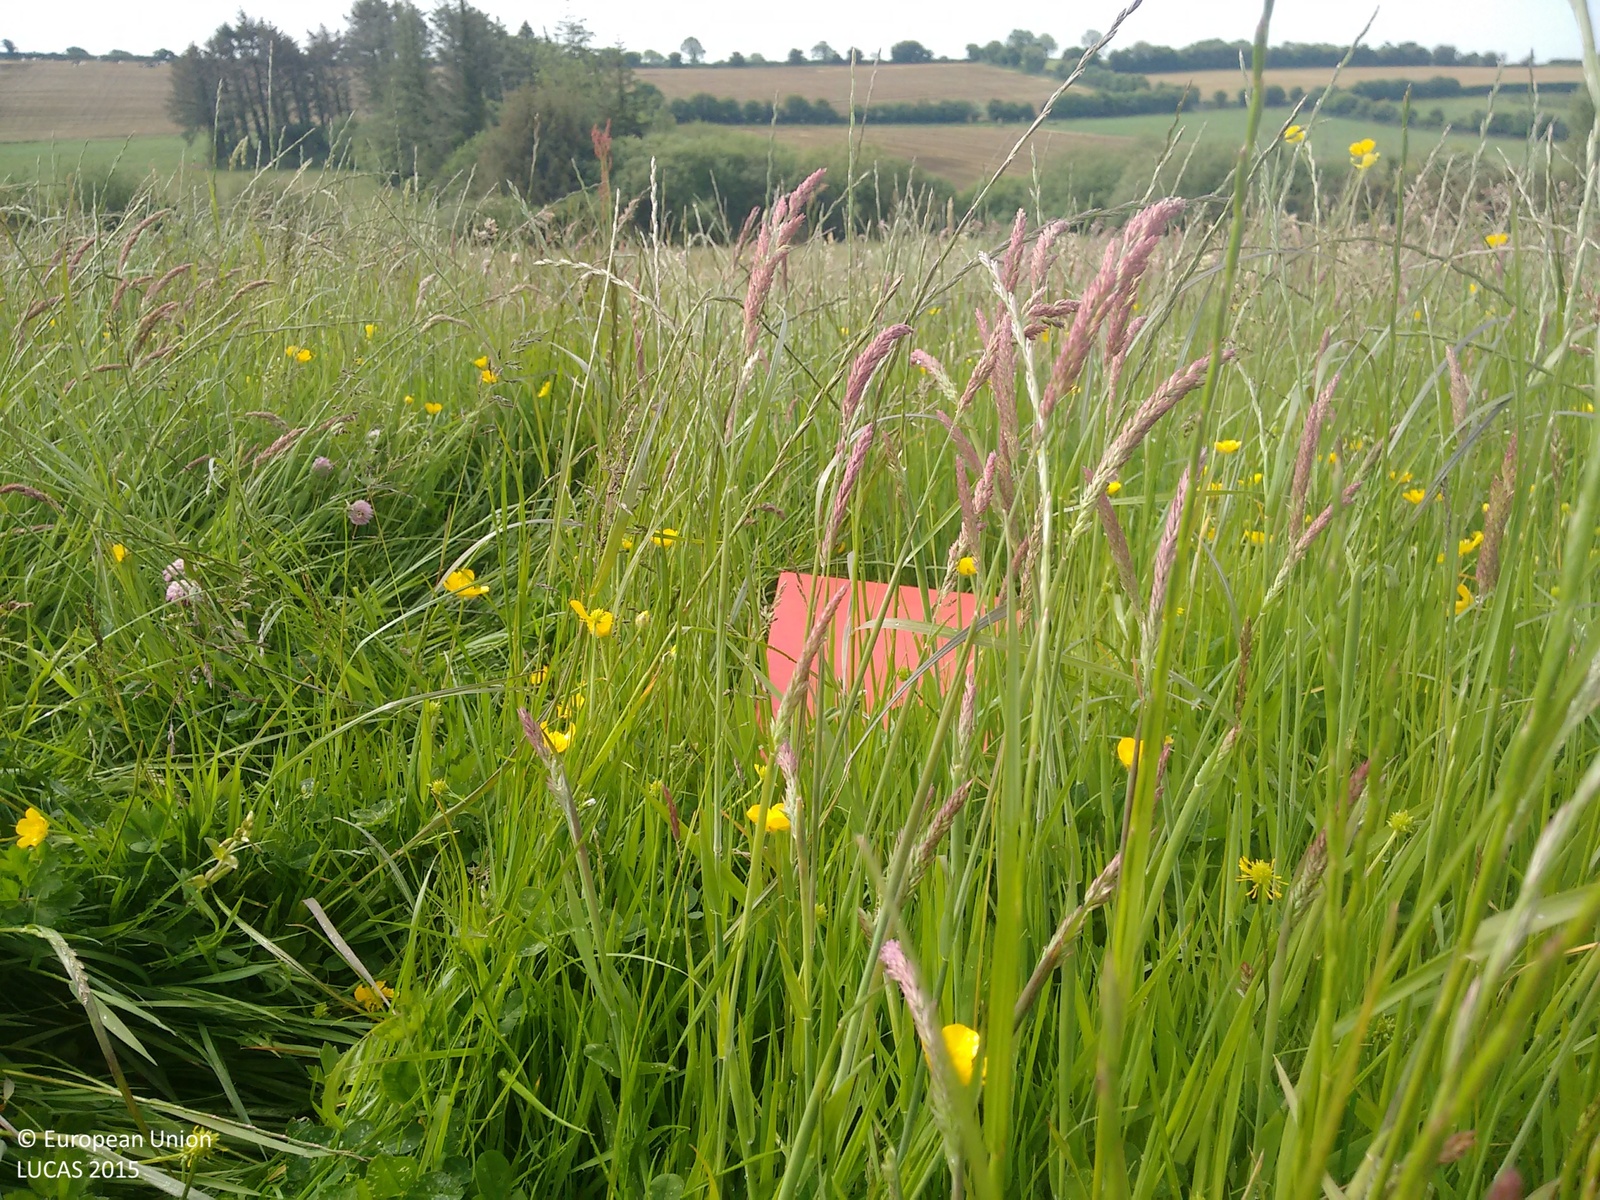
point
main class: Grassland
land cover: Grassland without tree/shrub cover
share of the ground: > 75 %
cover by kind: herbaceous plants 100 %
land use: Agriculture (excluding fallow land and kitchen gardens)
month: June
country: IE
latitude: 51.6581
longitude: -8.7499
